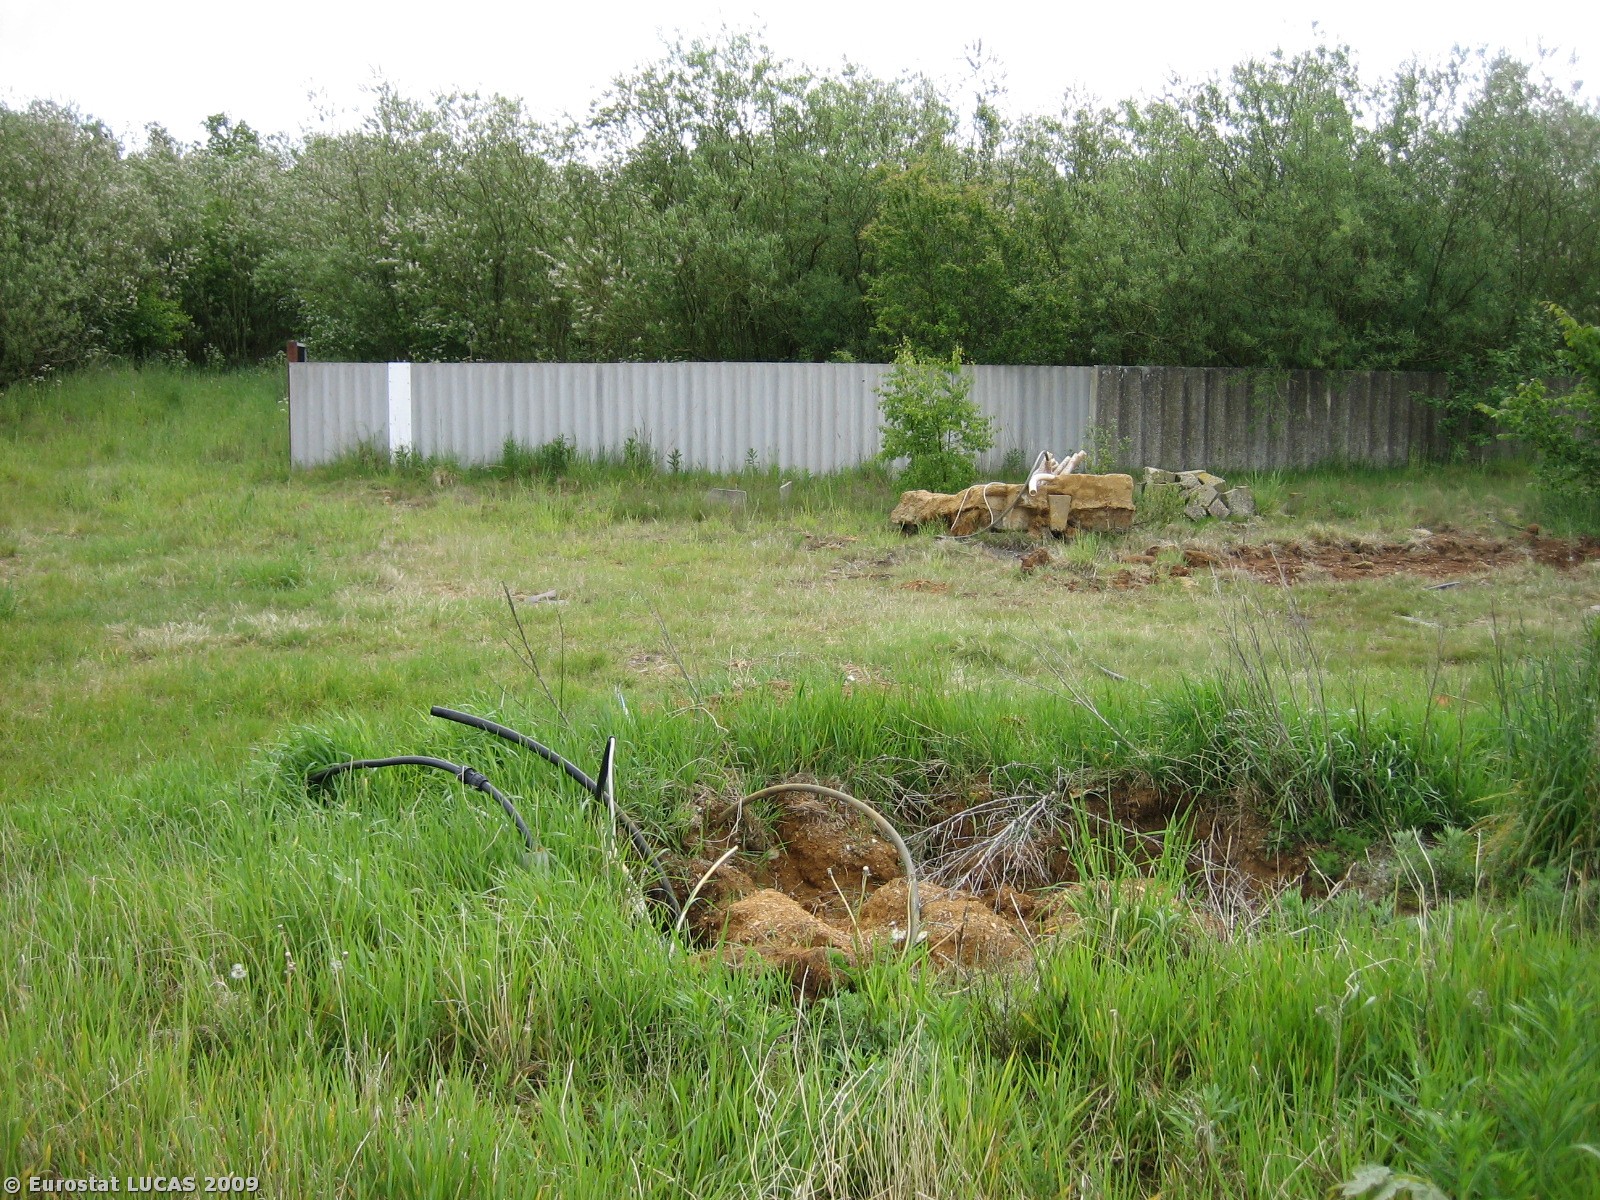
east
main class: Grassland
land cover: Grassland with sparse tree/shrub cover
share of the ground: > 75 %
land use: Logistics and storage
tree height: > 5 m
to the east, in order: Grassland with sparse tree/shrub cover; Bare land; Grassland with sparse tree/shrub cover; Fences; Broadleaved woodland; Tracks; Broadleaved woodland; Mixed woodland; Grass margins; Coniferous woodland; Grass margins; Coniferous woodland; Grass margins; Coniferous woodland; Broadleaved woodland; Coniferous woodland
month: May
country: DK
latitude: 56.0922
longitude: 8.7959
